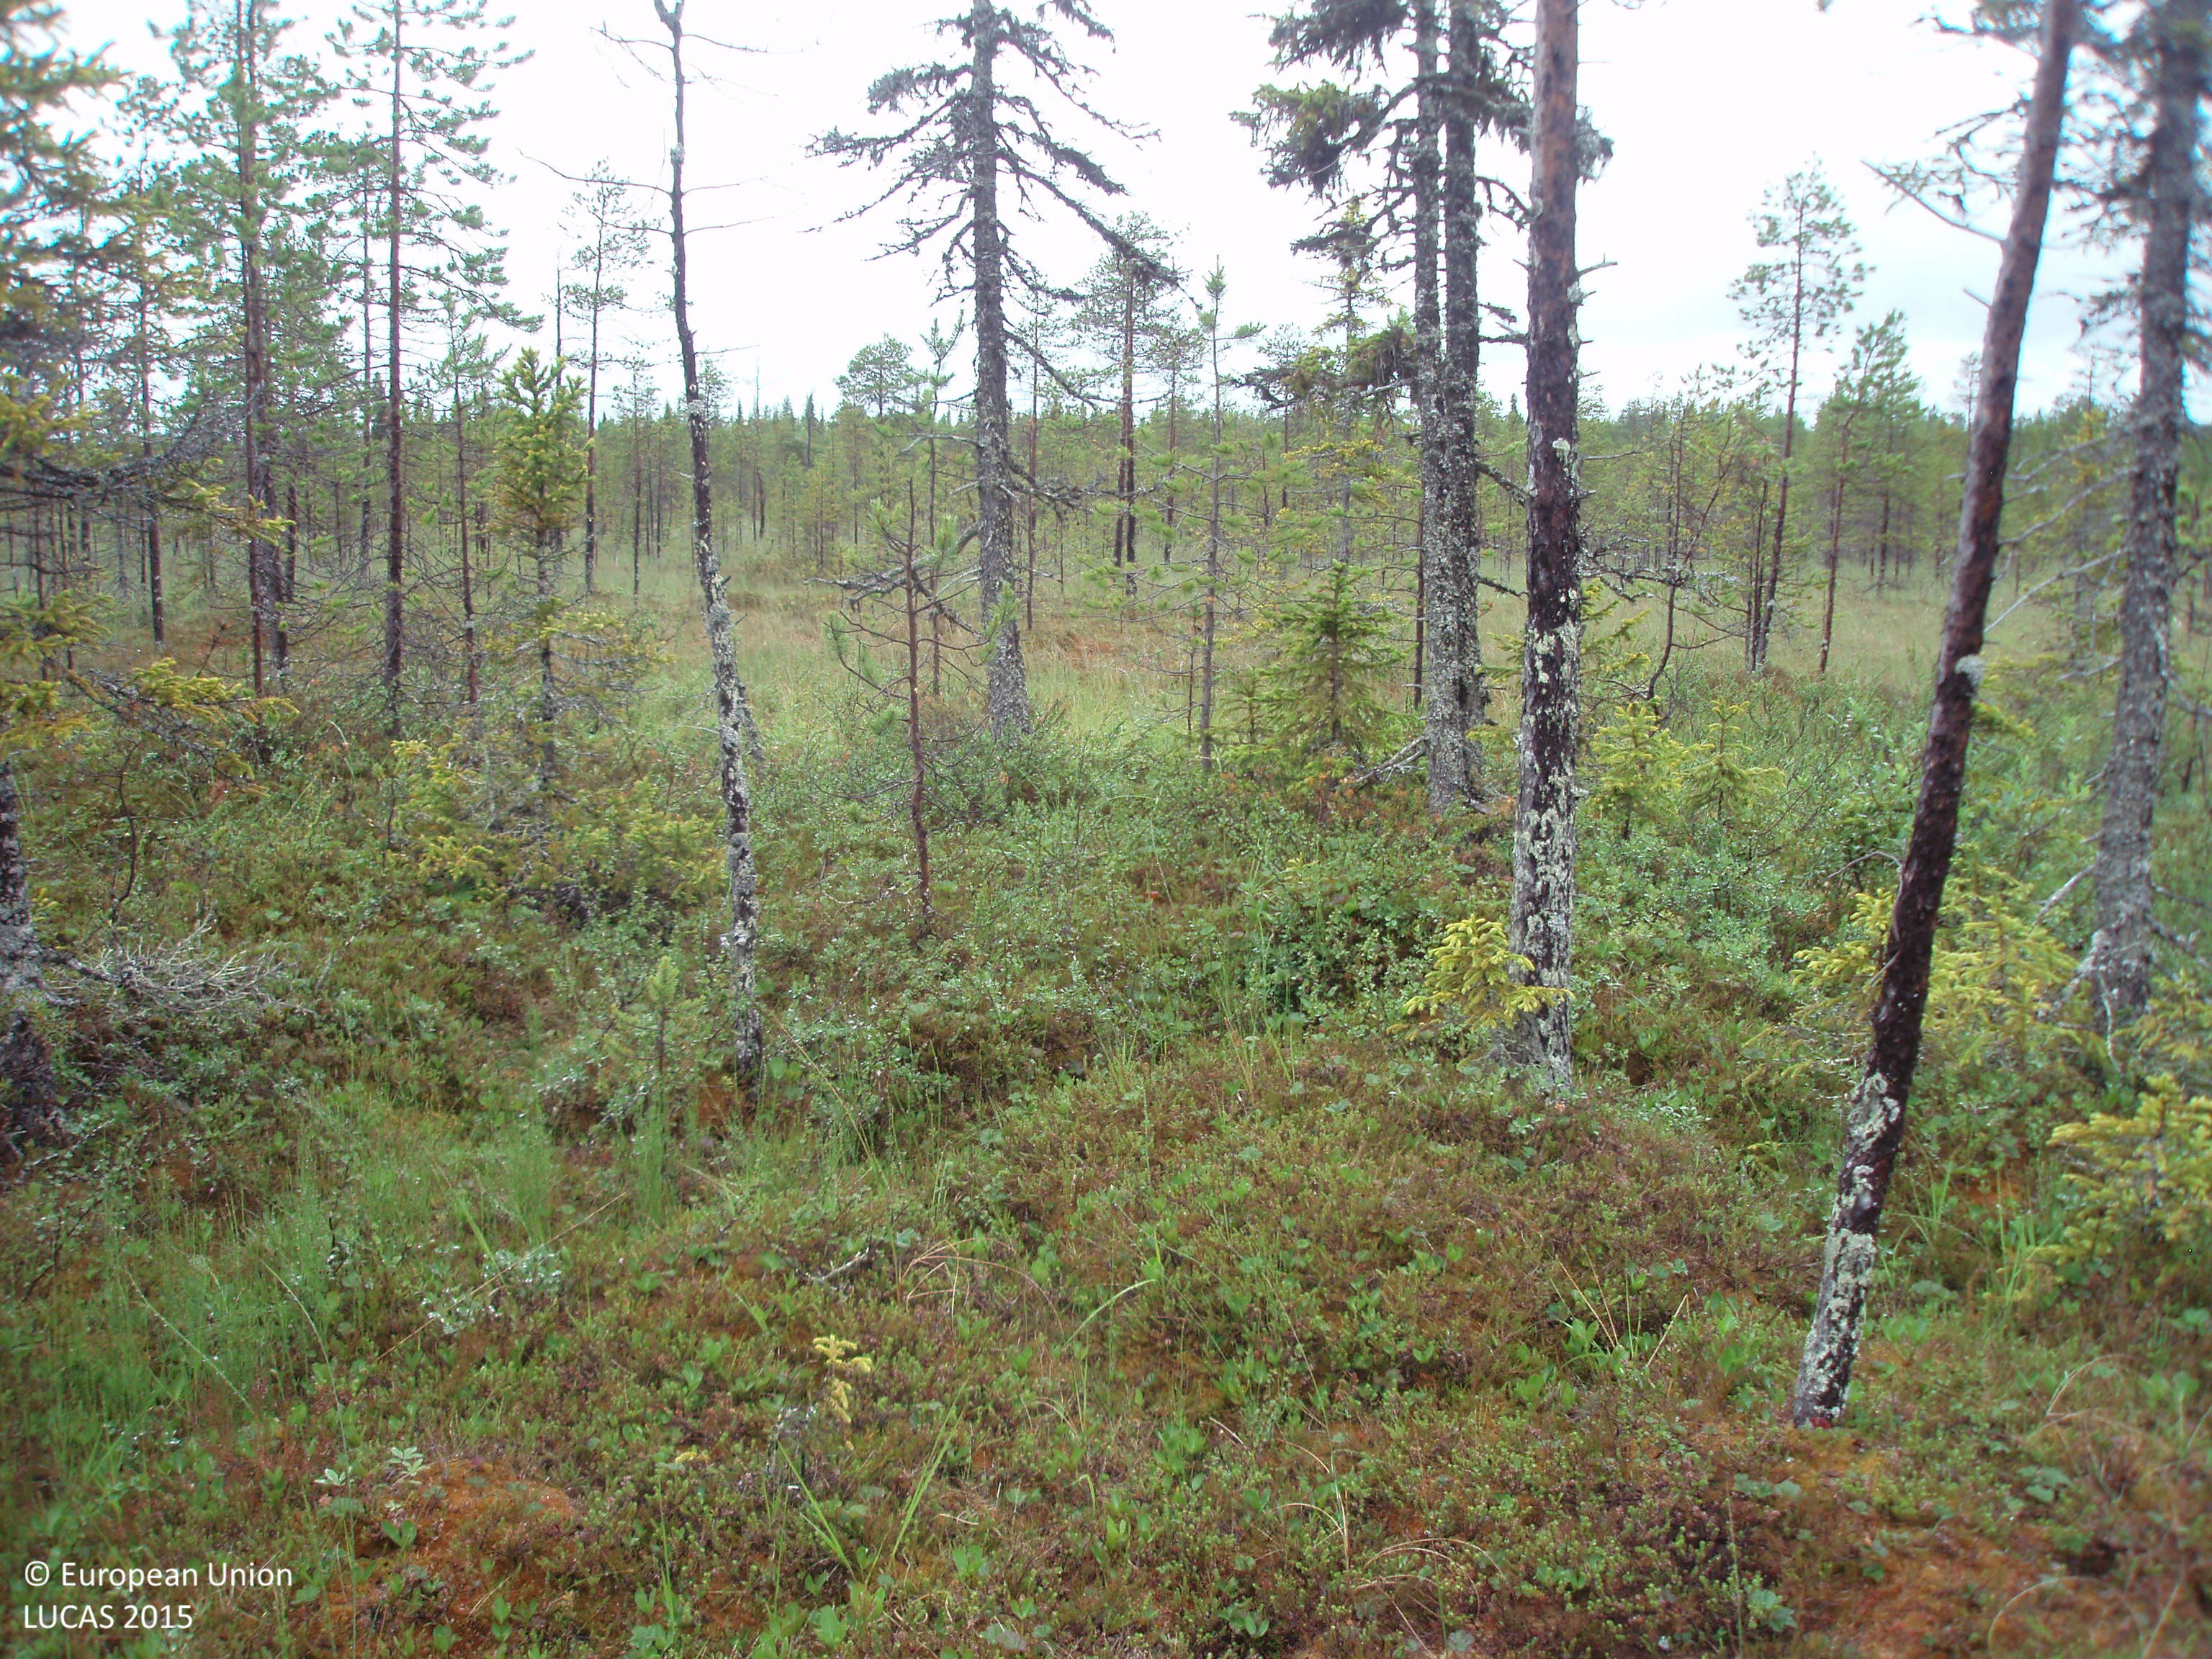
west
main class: Woodland
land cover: Pine dominated coniferous woodland
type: mire and swamp forests
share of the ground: 10 - 25 %
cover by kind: shrubs 45 %, lichens and mosses 35 %, coniferous forest trees 10 %, herbaceous plants 10 %
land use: Semi-natural and natural areas not in use
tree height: > 5 m
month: July
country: FI
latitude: 66.7888
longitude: 28.5369
